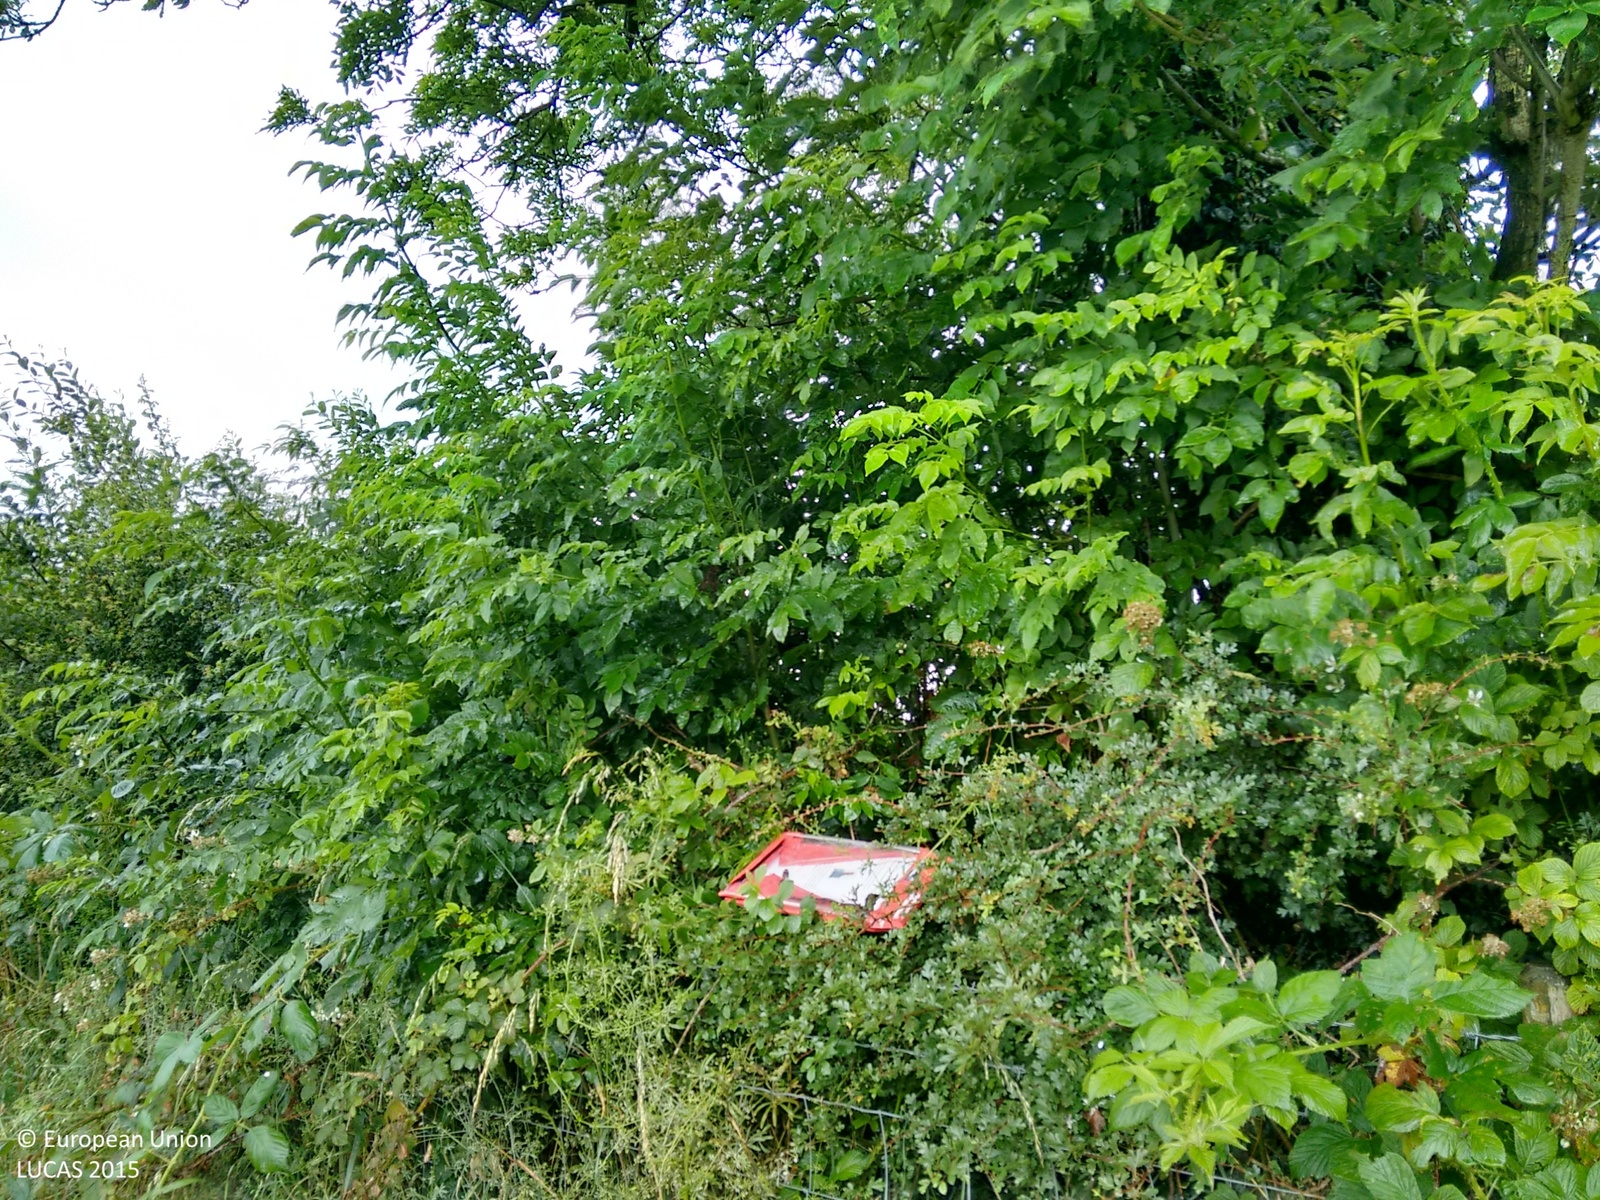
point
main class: Cropland
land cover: Other root crops
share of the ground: > 75 %
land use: Agriculture (excluding fallow land and kitchen gardens)
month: August
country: GB
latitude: 51.9421
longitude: -4.6114
